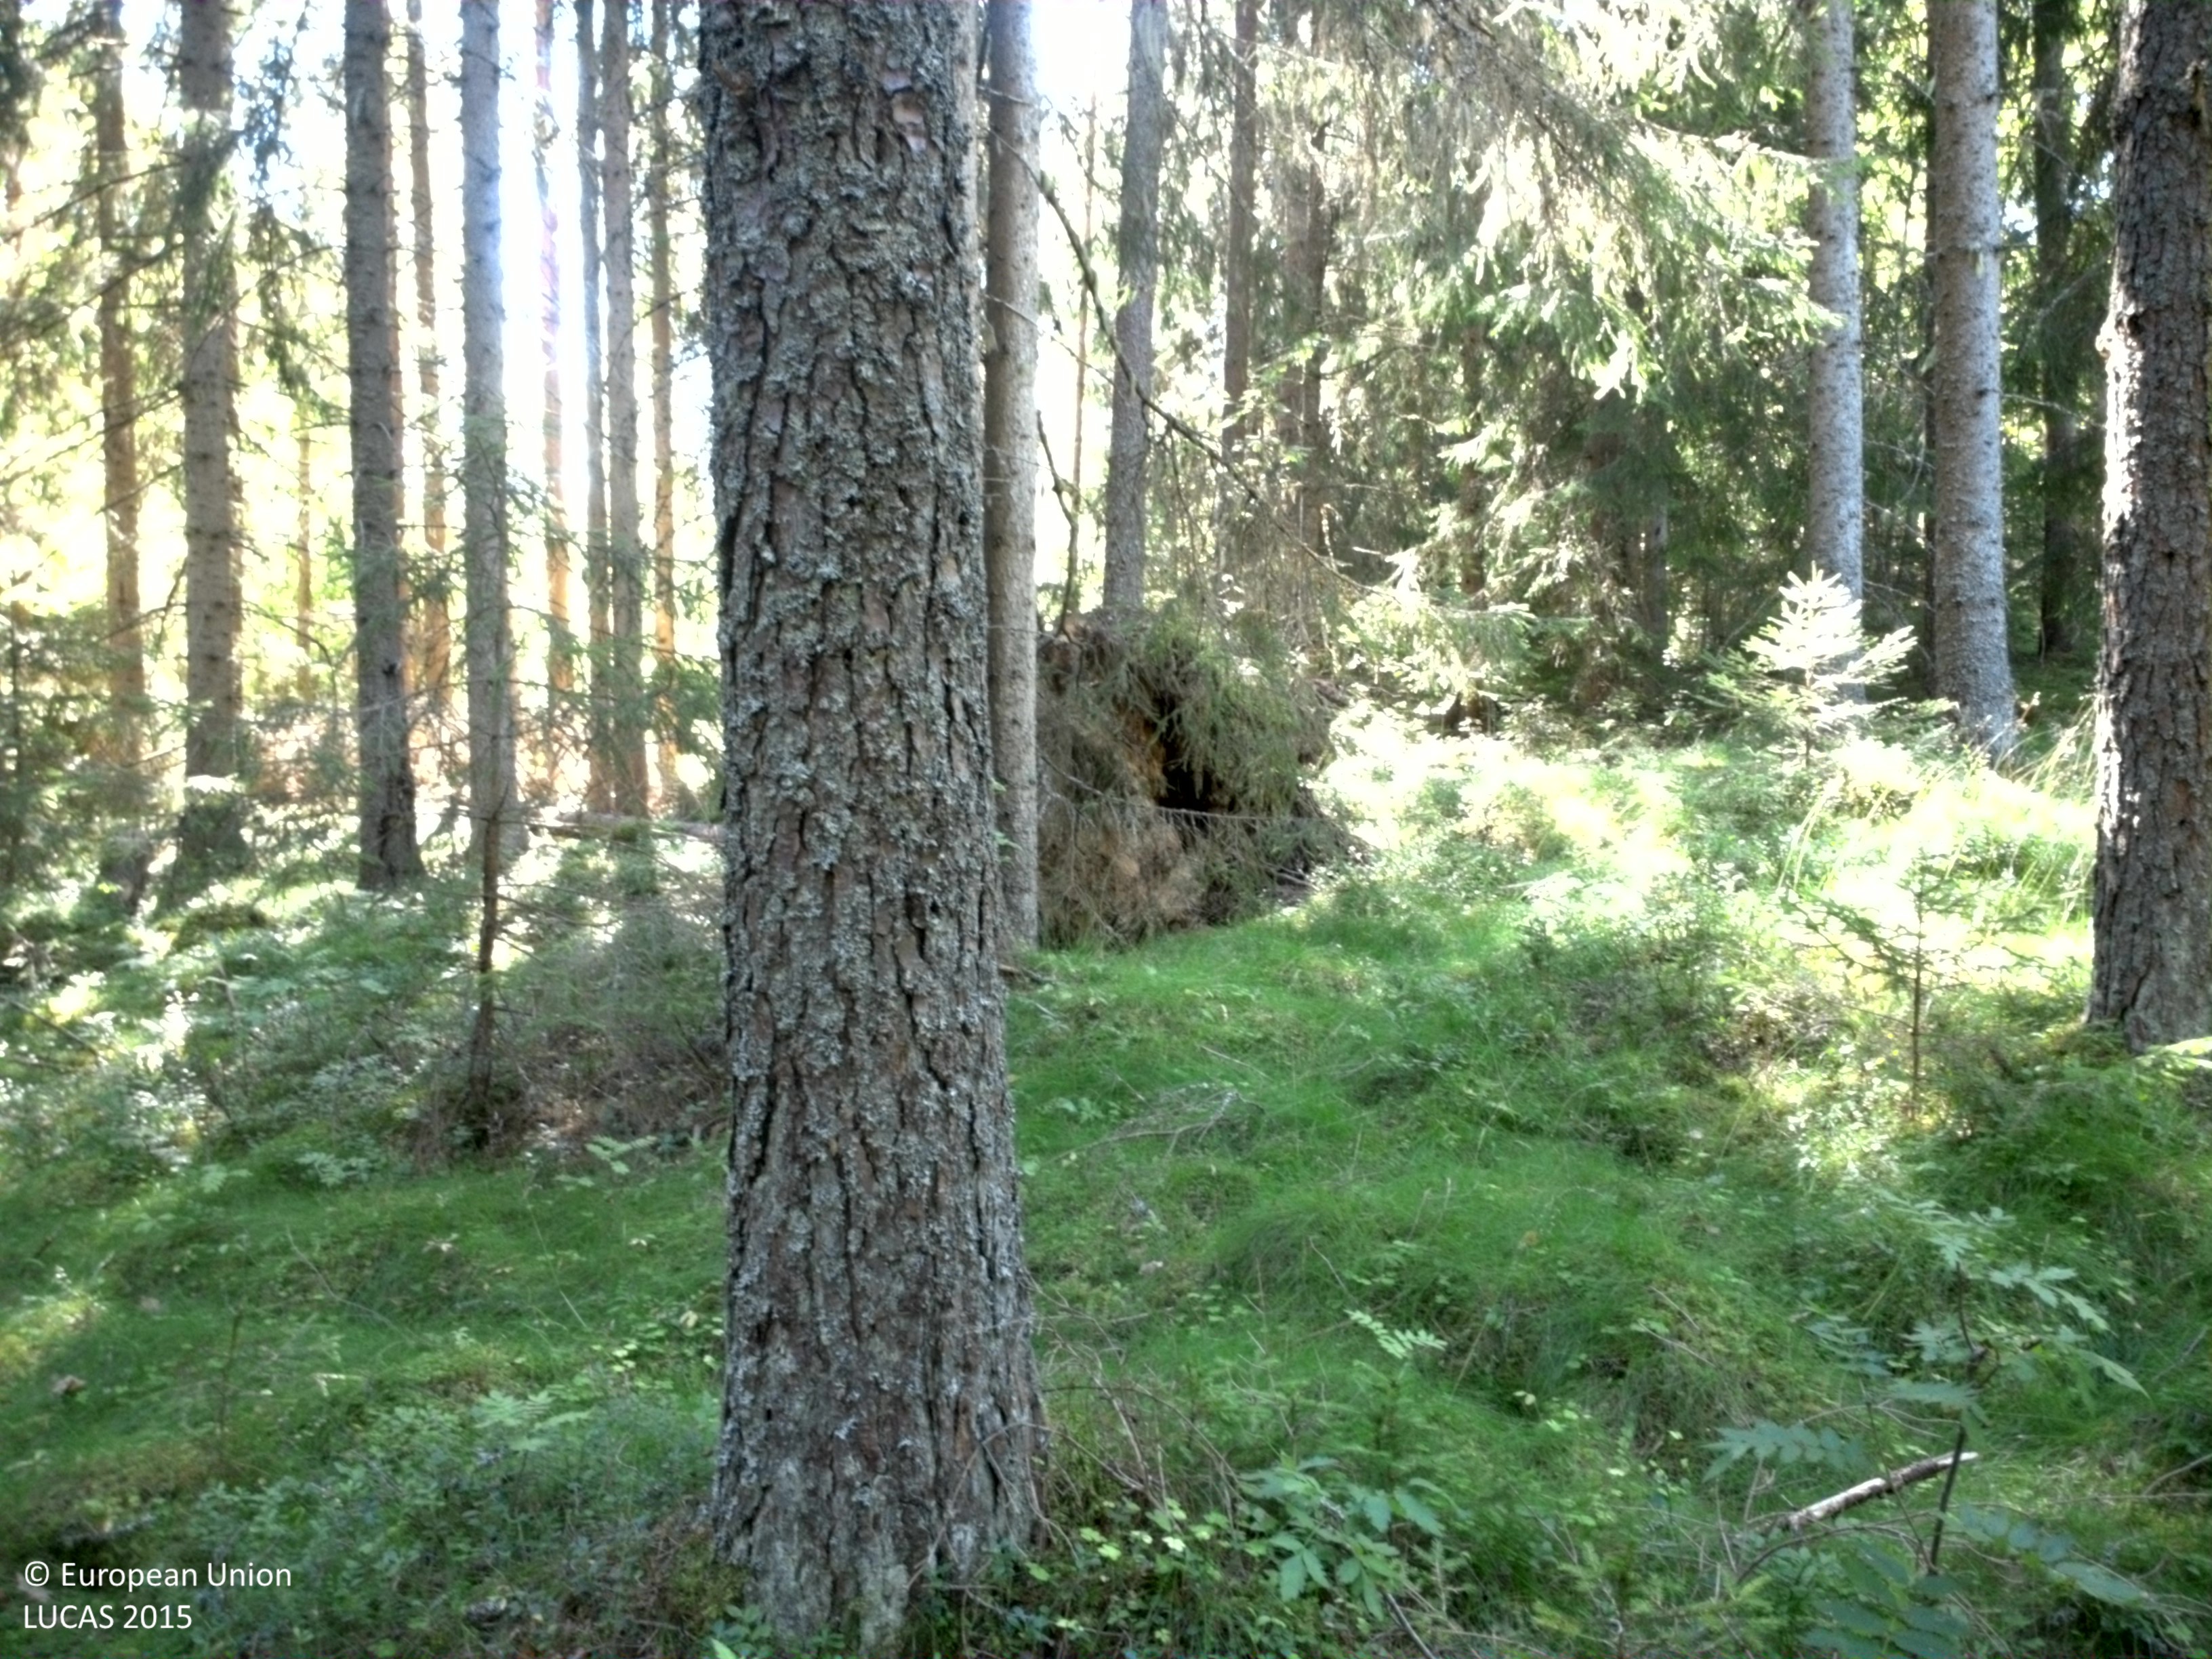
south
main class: Woodland
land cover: Spruce dominated coniferous woodland
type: boreal forest
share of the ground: 50 - 75 %
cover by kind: coniferous forest trees 65 %, lichens and mosses 20 %, broadleaved forest trees 5 %, shrubs 5 %, herbaceous plants 5 %
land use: Forestry
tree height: > 5 m
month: August
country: SE
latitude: 60.1183
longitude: 13.5354
